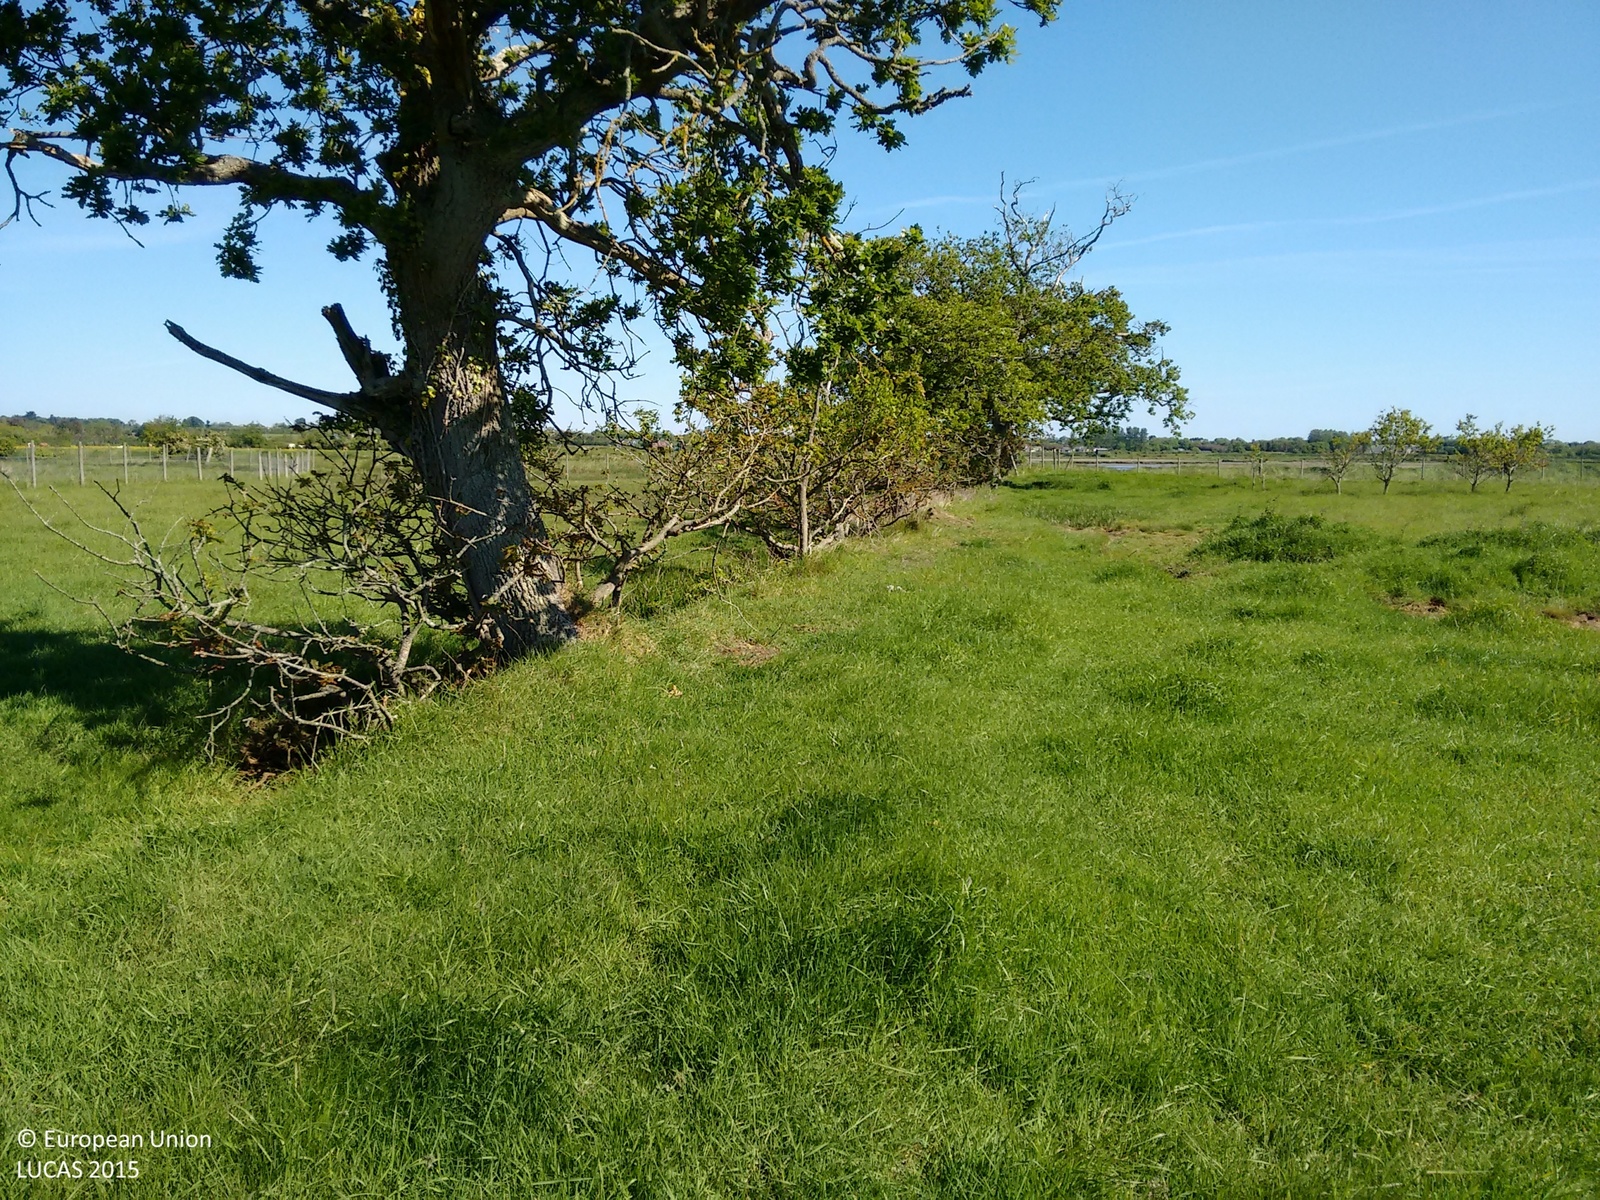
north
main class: Grassland
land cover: Grassland with sparse tree/shrub cover
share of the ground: > 75 %
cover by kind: herbaceous plants 80 %, unconsolidated bare surface 10 %, broadleaved forest trees 5 %, shrubs 5 %
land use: Agriculture (excluding fallow land and kitchen gardens)
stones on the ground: < 10 %
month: June
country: IE
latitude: 53.4980
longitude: -6.1717
